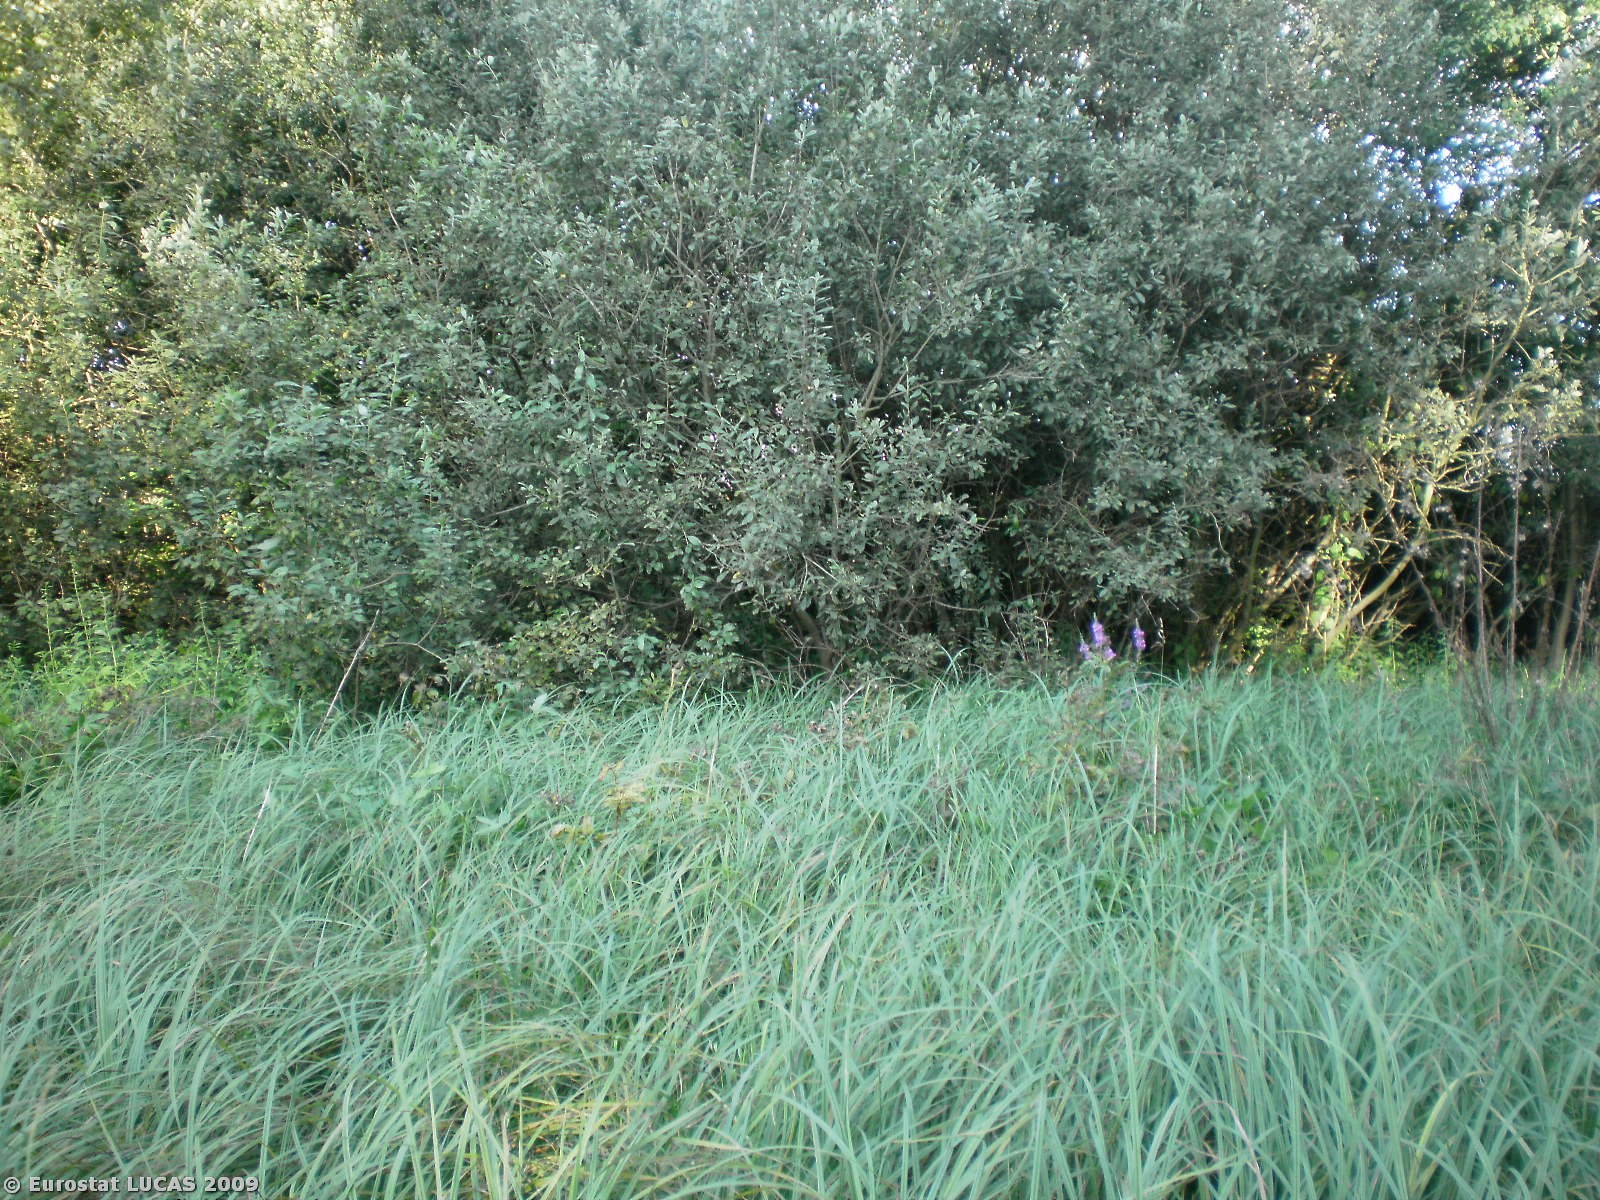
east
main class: Grassland
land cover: Grassland without tree/shrub cover
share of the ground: > 75 %
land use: Agriculture (excluding fallow land and kitchen gardens)
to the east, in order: Grassland without tree/shrub cover; Shrubland without tree cover; Grassland with sparse tree/shrub cover; Broadleaved woodland; Grassland without tree/shrub cover
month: August
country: PL
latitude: 52.5400
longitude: 21.7167
